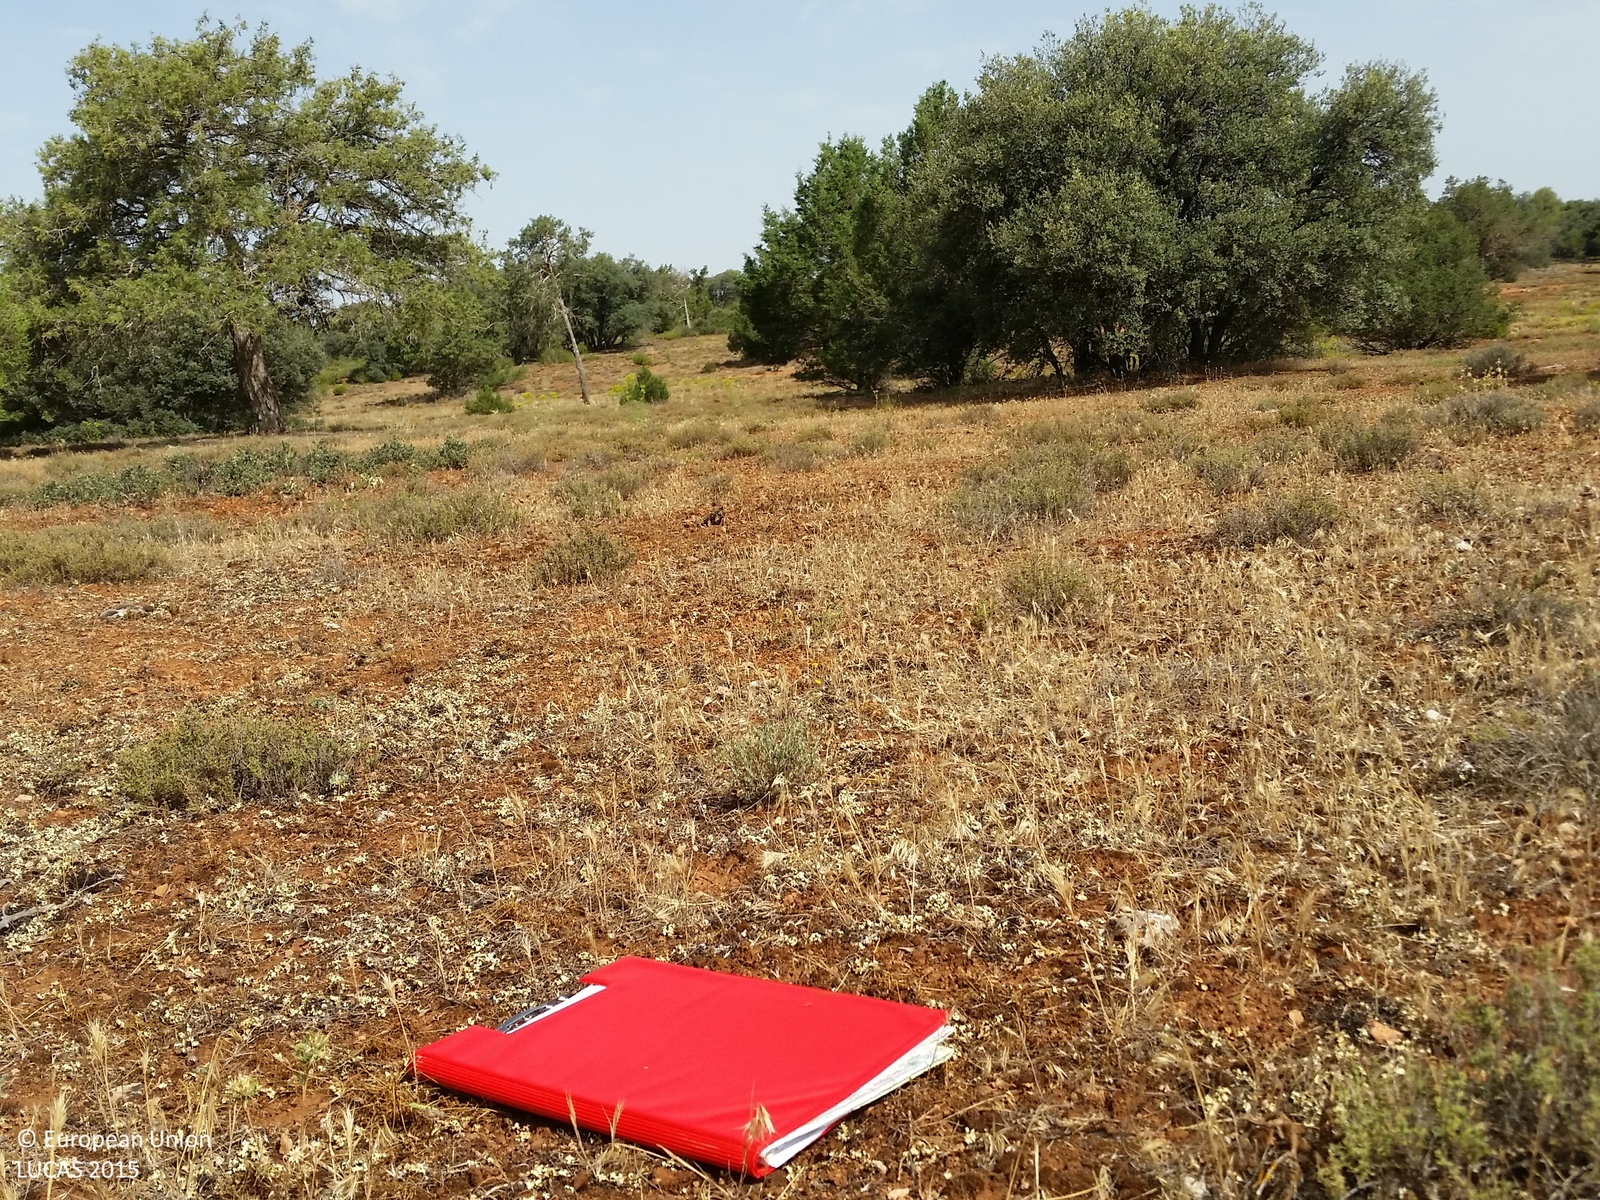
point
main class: Woodland
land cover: Pine dominated coniferous woodland
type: coniferous forest of the mediterranean region
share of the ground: > 75 %
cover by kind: coniferous forest trees 50 %, shrubs 20 %, herbaceous plants 15 %, consolidated bare surface 15 %
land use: Semi-natural and natural areas not in use
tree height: > 5 m
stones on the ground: 10 - 25 %
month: July
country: ES
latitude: 38.8925
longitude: -2.6765
